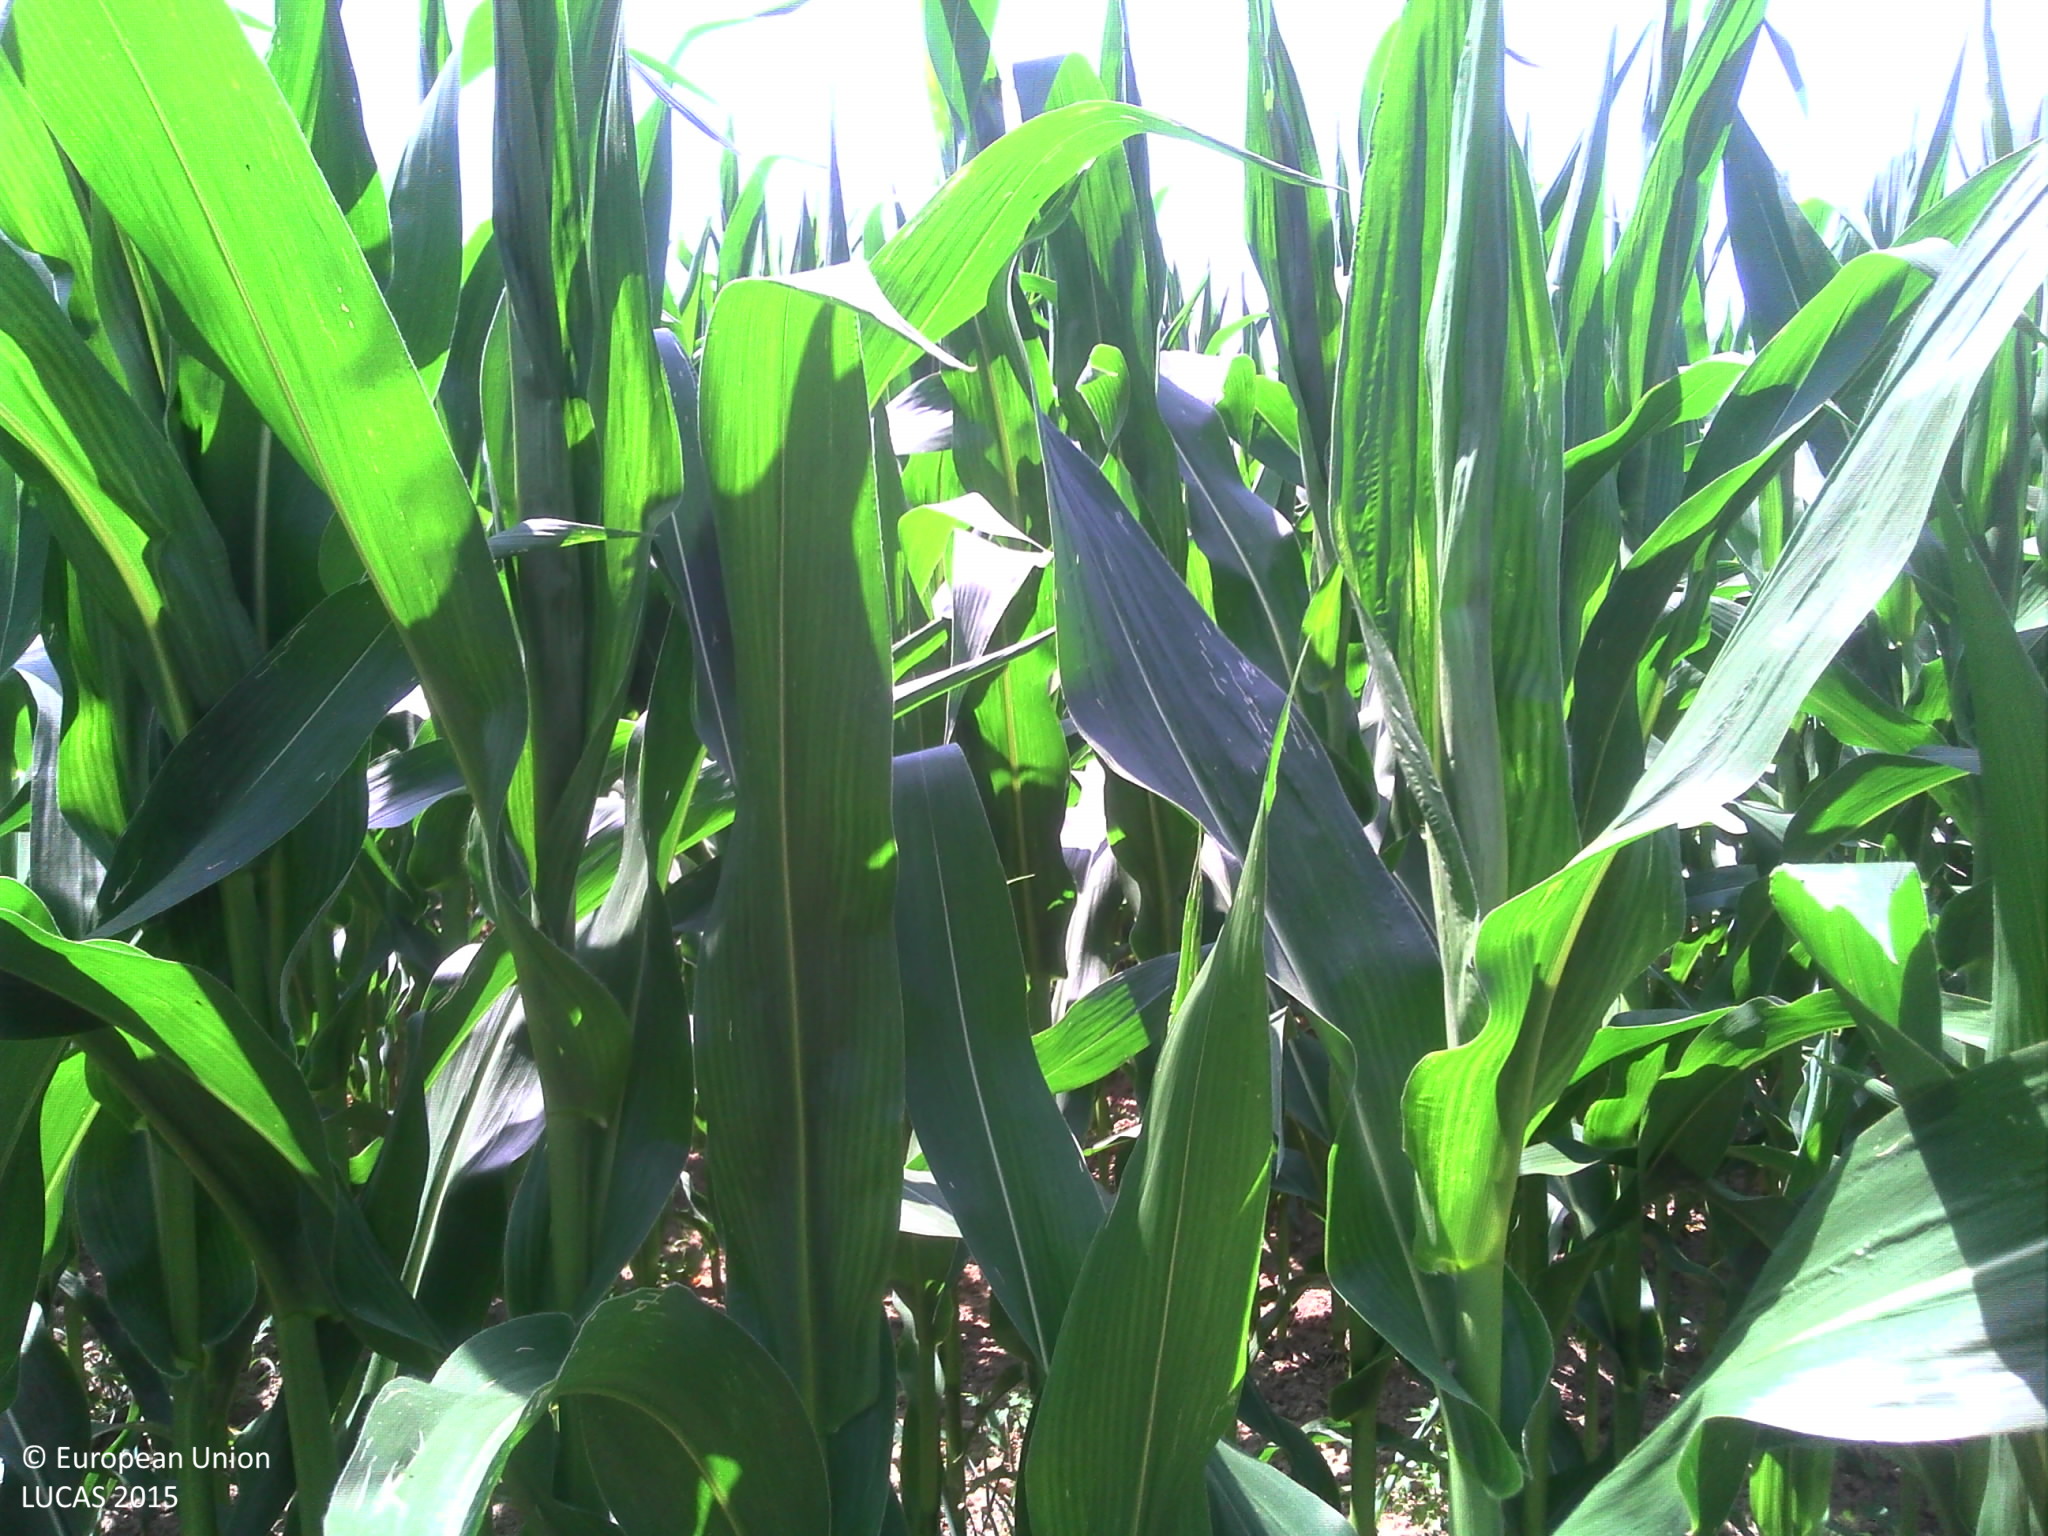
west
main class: Cropland
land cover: Maize
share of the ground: > 75 %
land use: Agriculture (excluding fallow land and kitchen gardens)
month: July
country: FR
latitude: 46.8227
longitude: 5.2436
